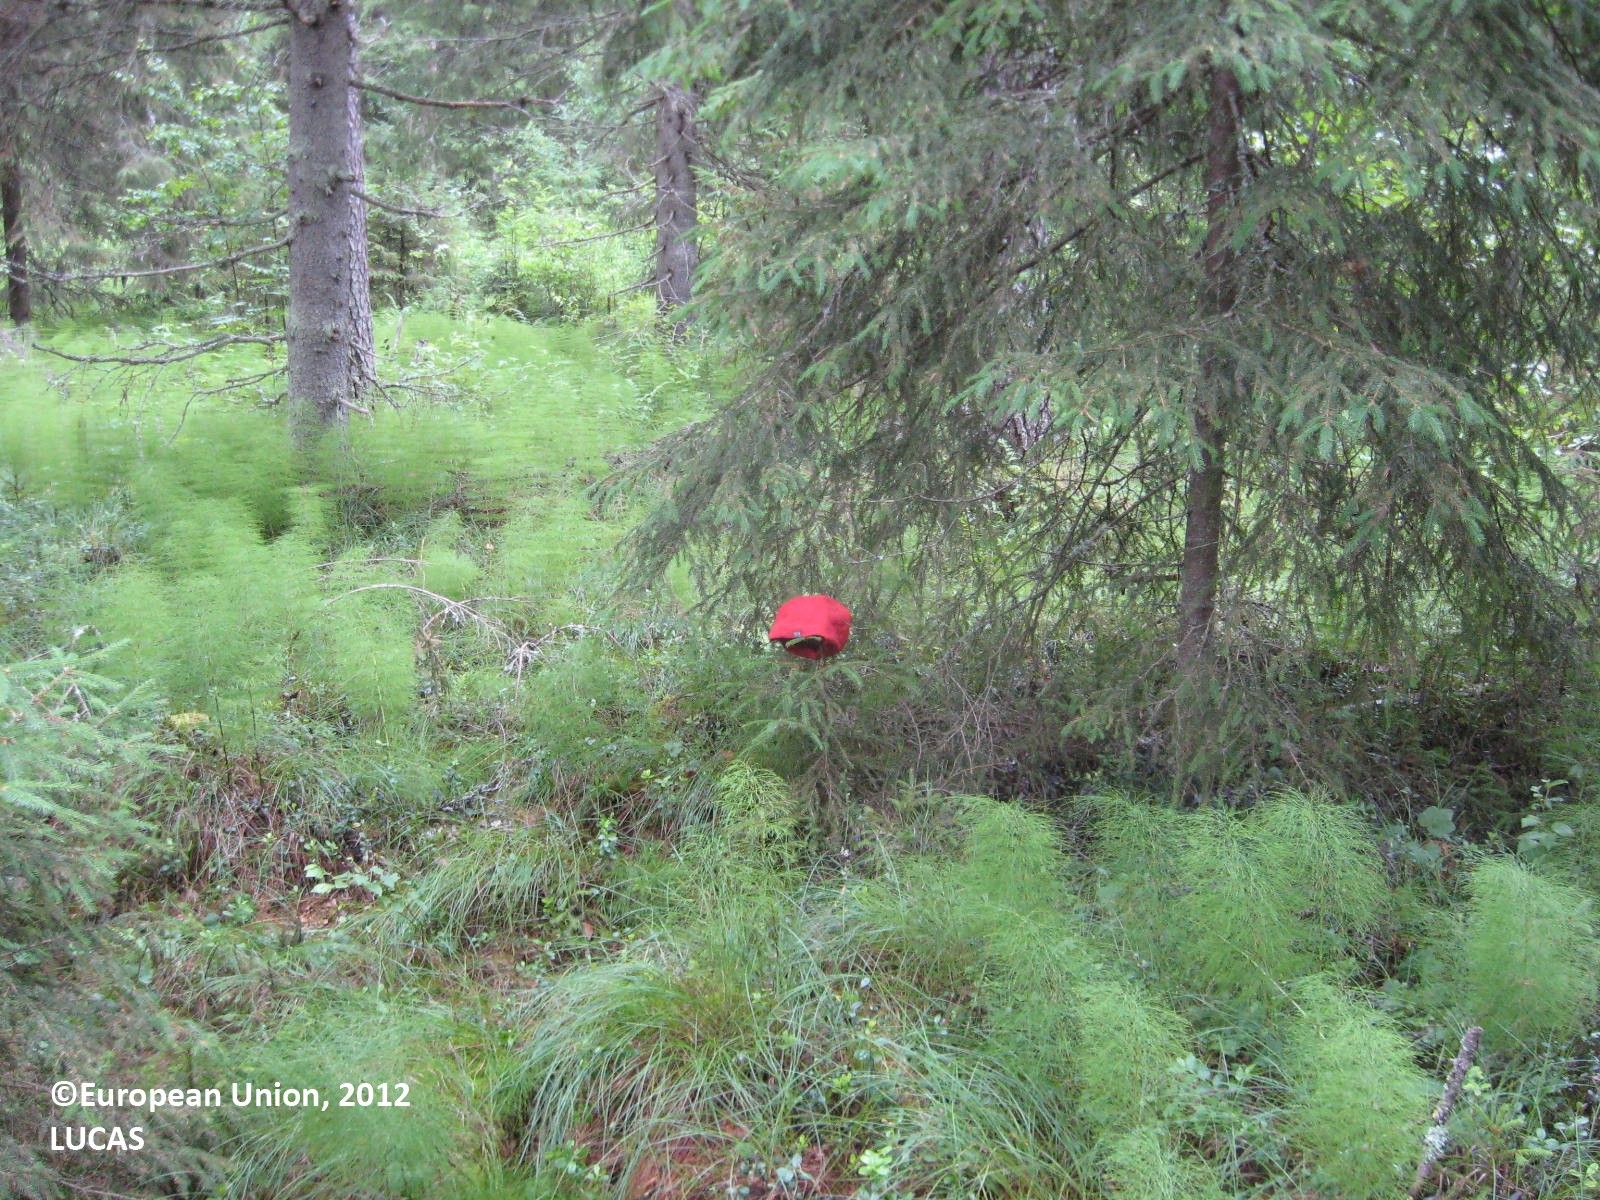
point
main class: Woodland
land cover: Other coniferous woodland
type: boreal forest
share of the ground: > 75 %
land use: Forestry
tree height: > 5 m
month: July
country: FI
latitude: 62.3588
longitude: 21.6583
